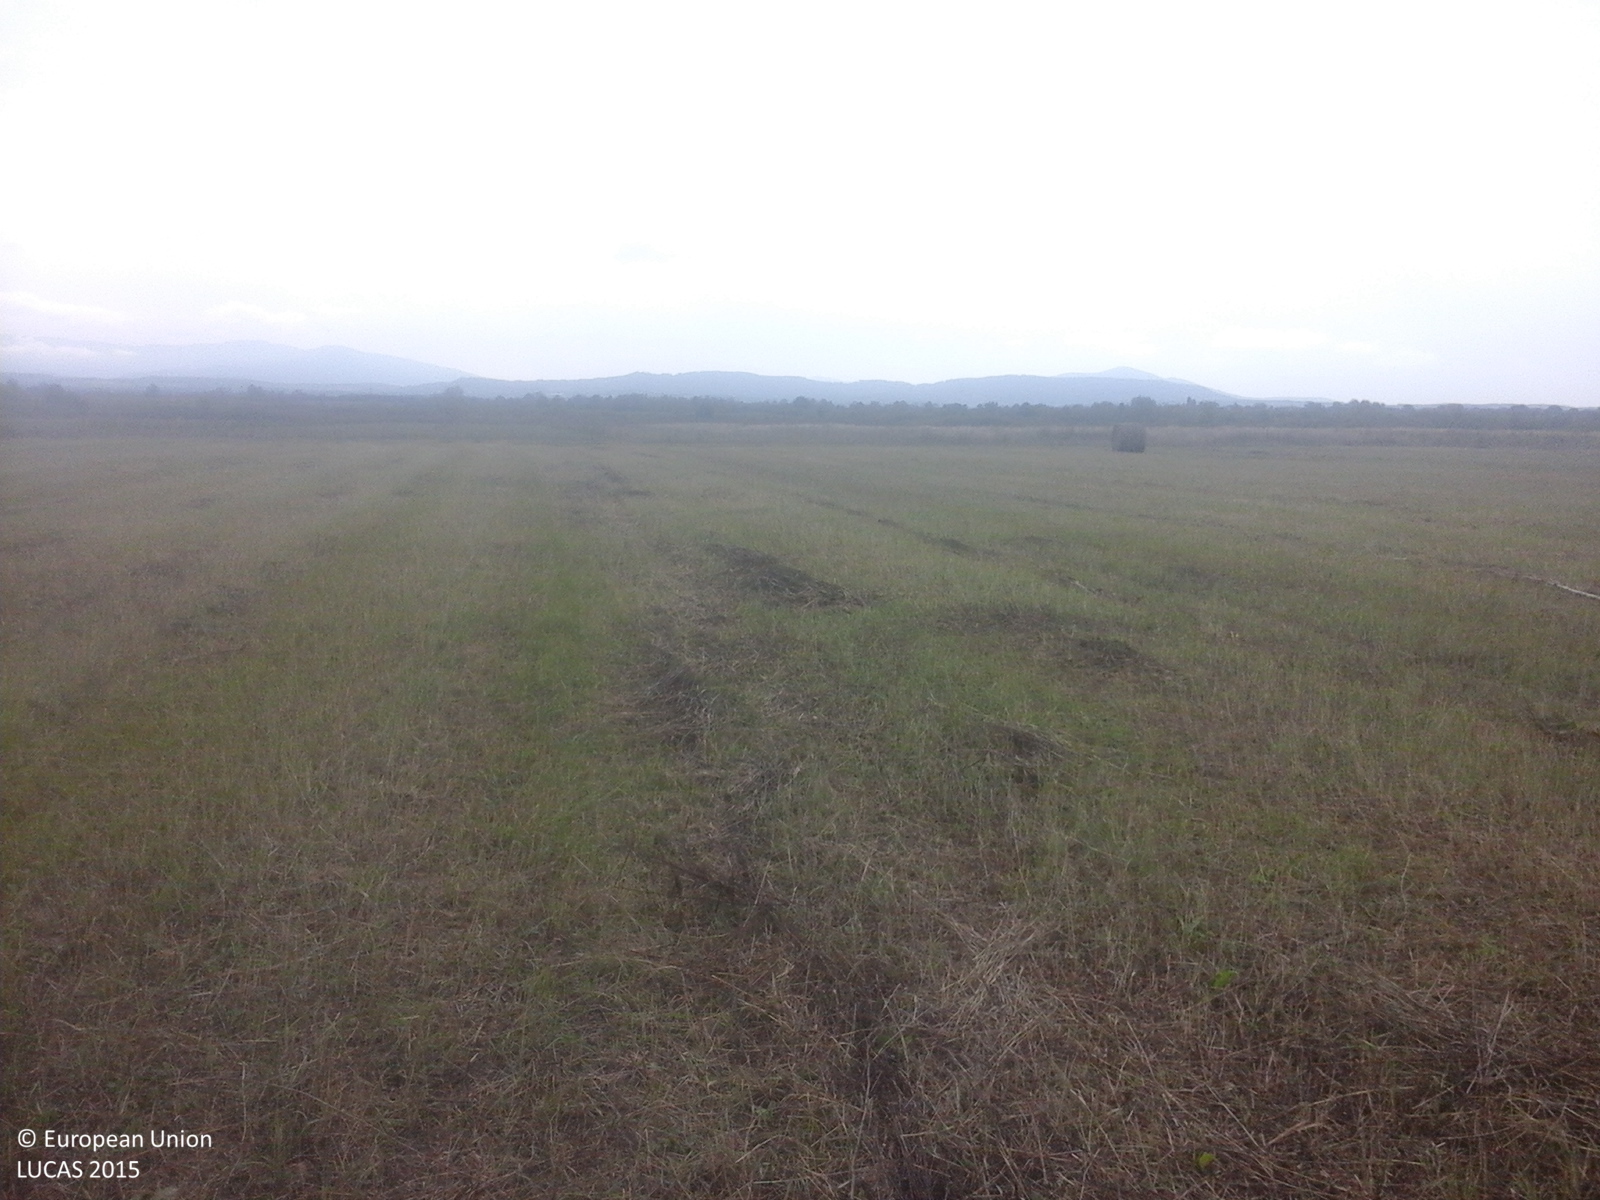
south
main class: Grassland
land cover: Grassland without tree/shrub cover
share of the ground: > 75 %
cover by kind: herbaceous plants 100 %
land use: Agriculture (excluding fallow land and kitchen gardens)
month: September
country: RO
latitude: 45.8398
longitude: 22.1323
